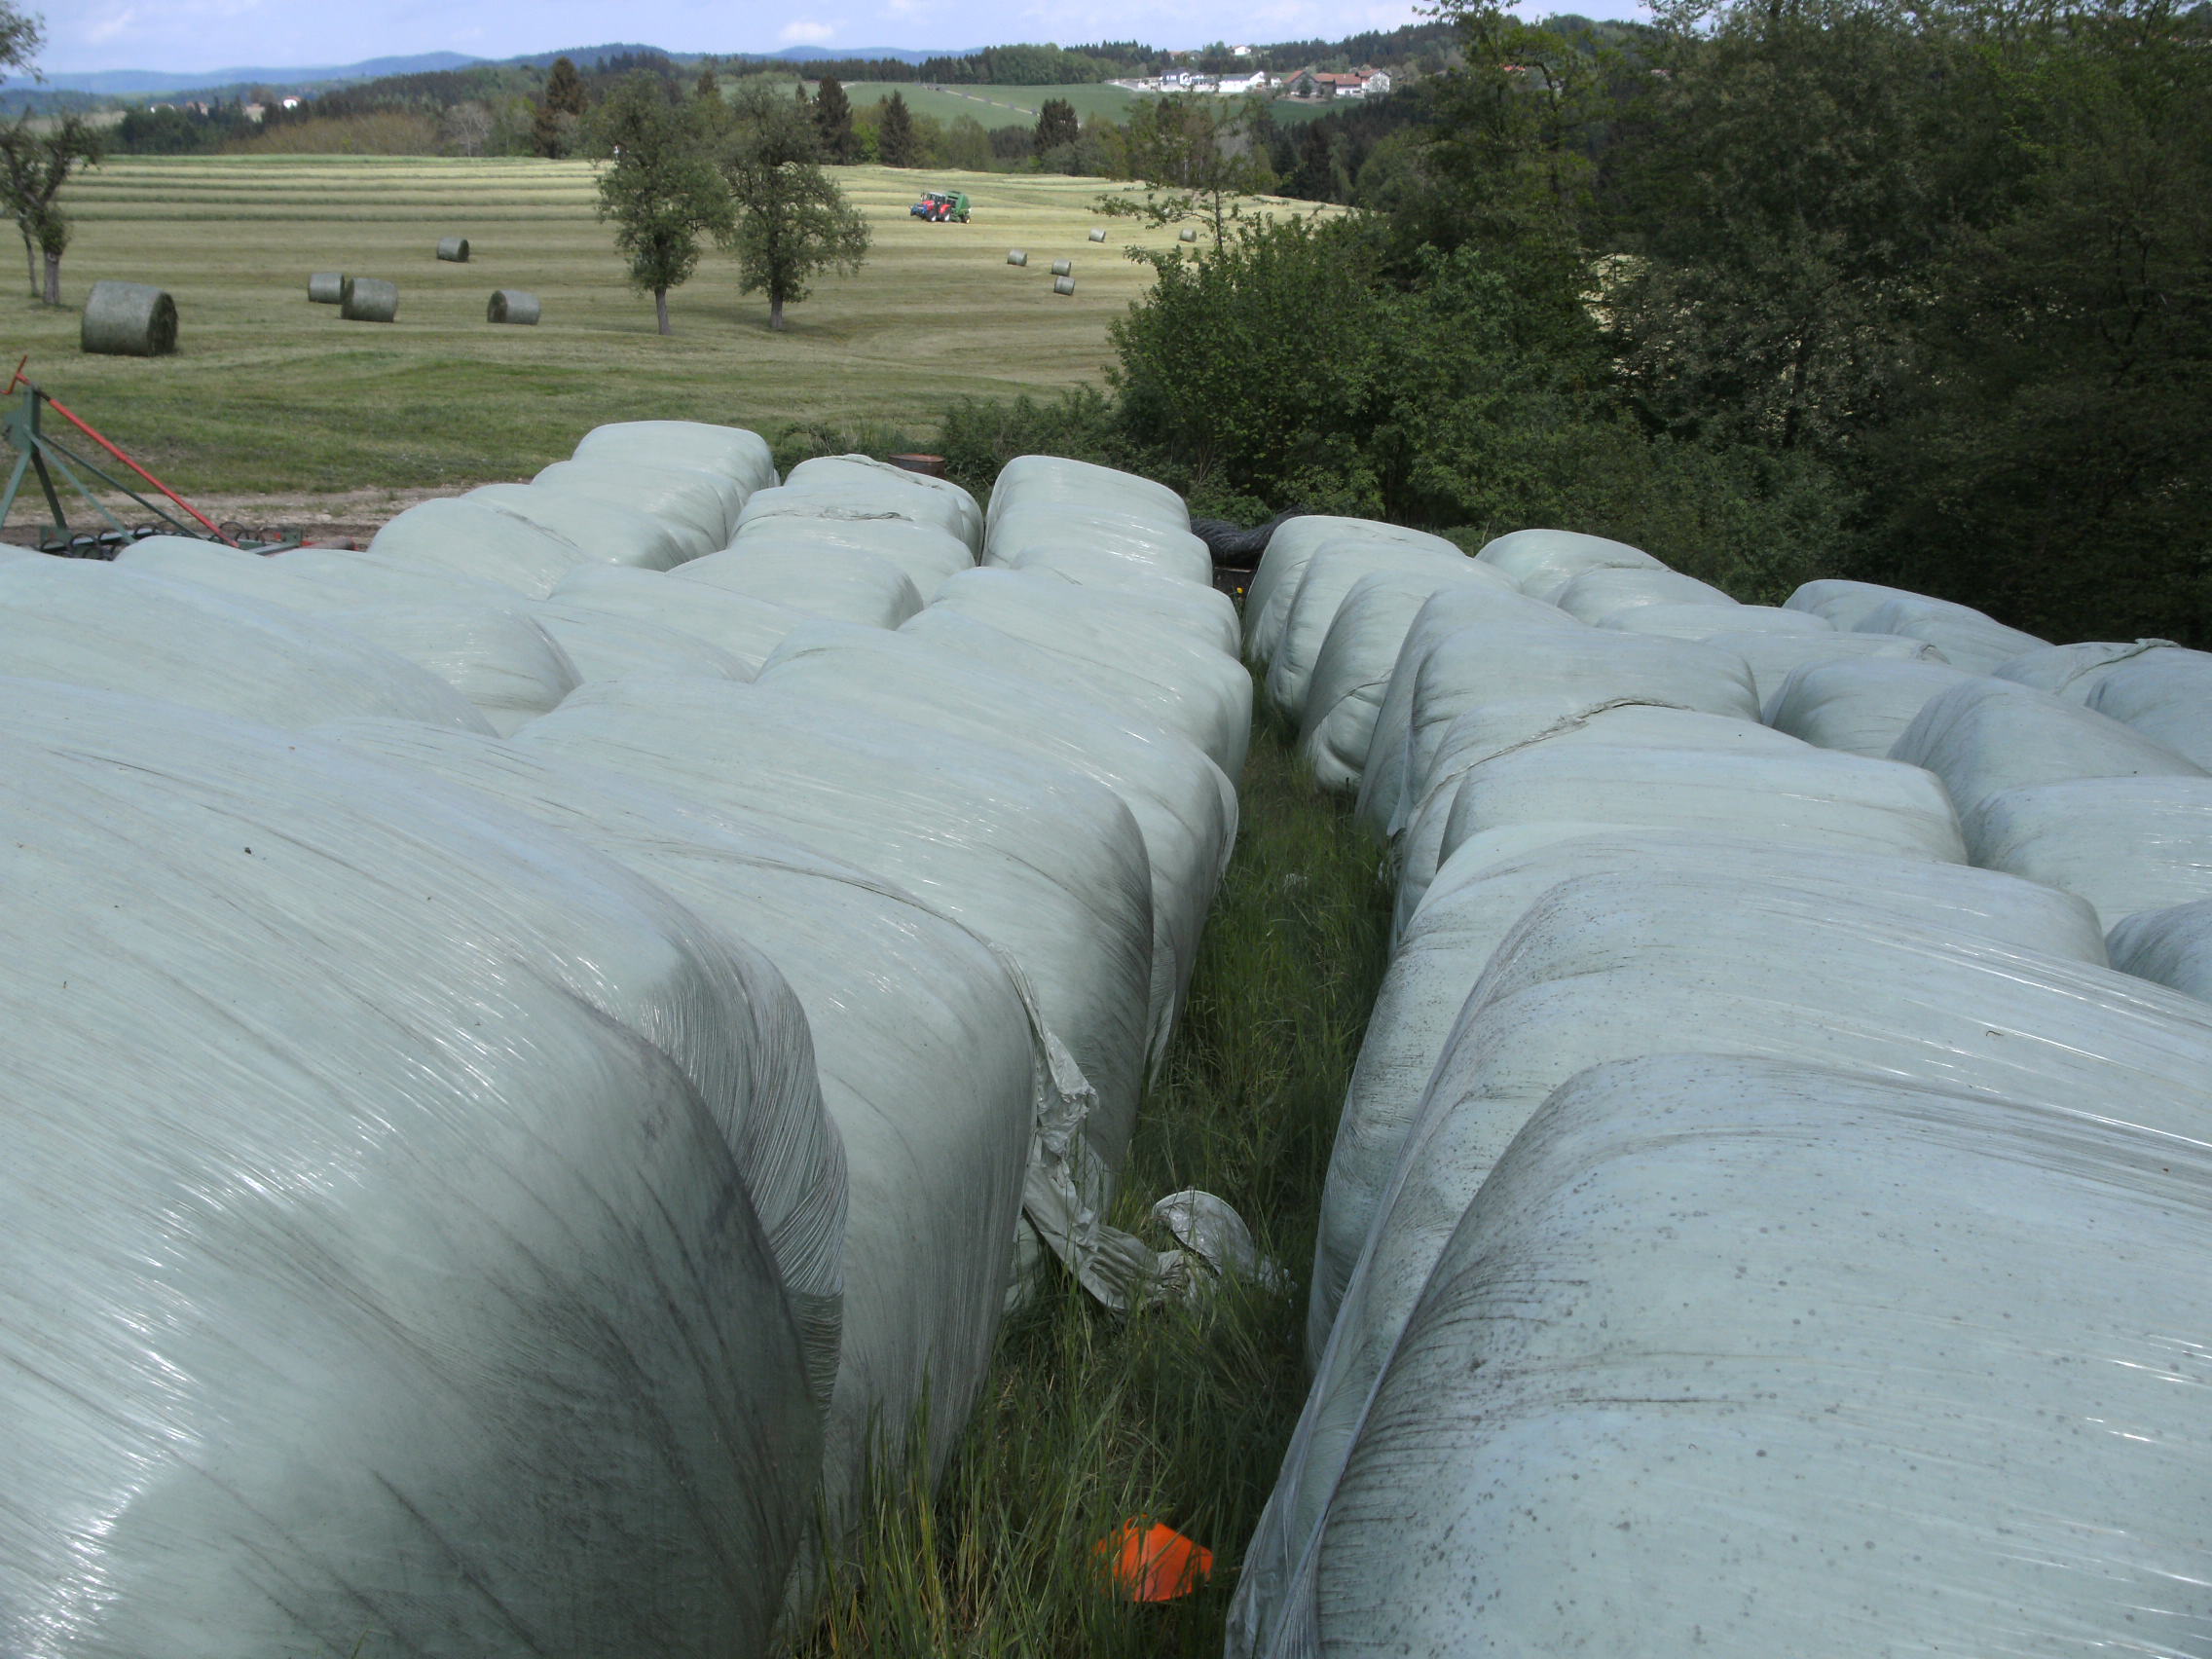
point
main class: Grassland
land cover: Spontaneously vegetated surfaces
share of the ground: 10 - 25 %
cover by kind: consolidated bare surface 30 %, herbaceous plants 15 %
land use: Agriculture (excluding fallow land and kitchen gardens)
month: May
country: AT
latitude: 48.5451
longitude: 13.5351
